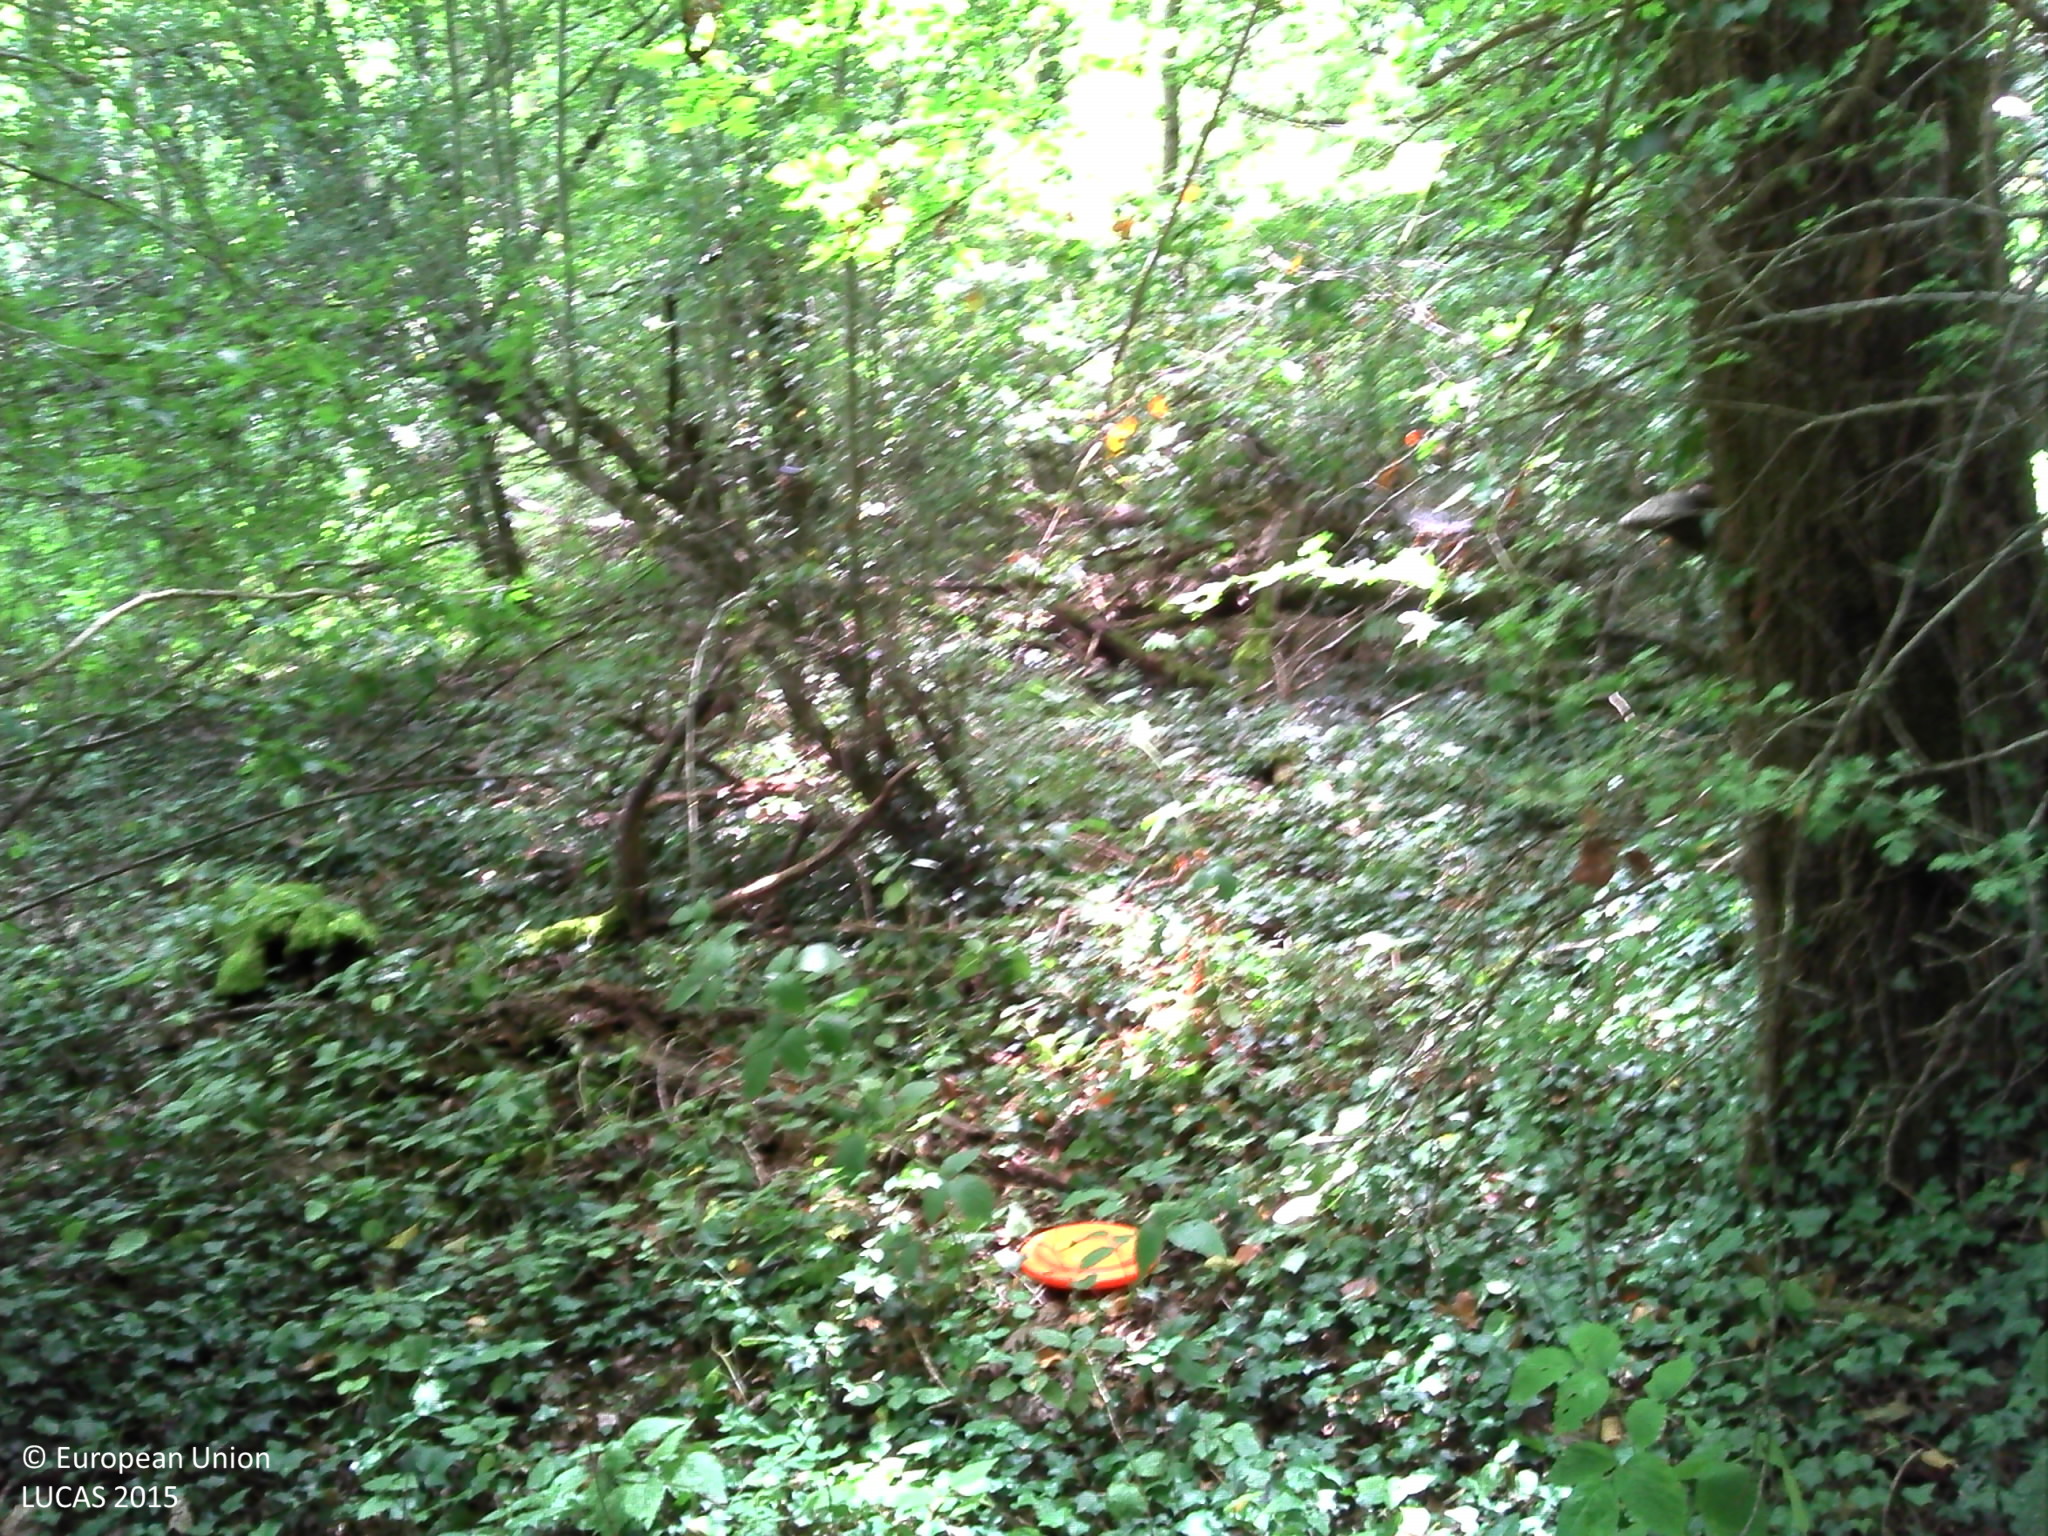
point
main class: Woodland
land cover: Broadleaved woodland
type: mesophytic deciduous forest
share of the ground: > 75 %
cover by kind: broadleaved forest trees 90 %, herbaceous plants 5 %, lichens and mosses 5 %
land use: Forestry
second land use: Amenities, museums, leisure
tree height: > 5 m
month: July
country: FR
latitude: 48.1337
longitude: 3.0997
